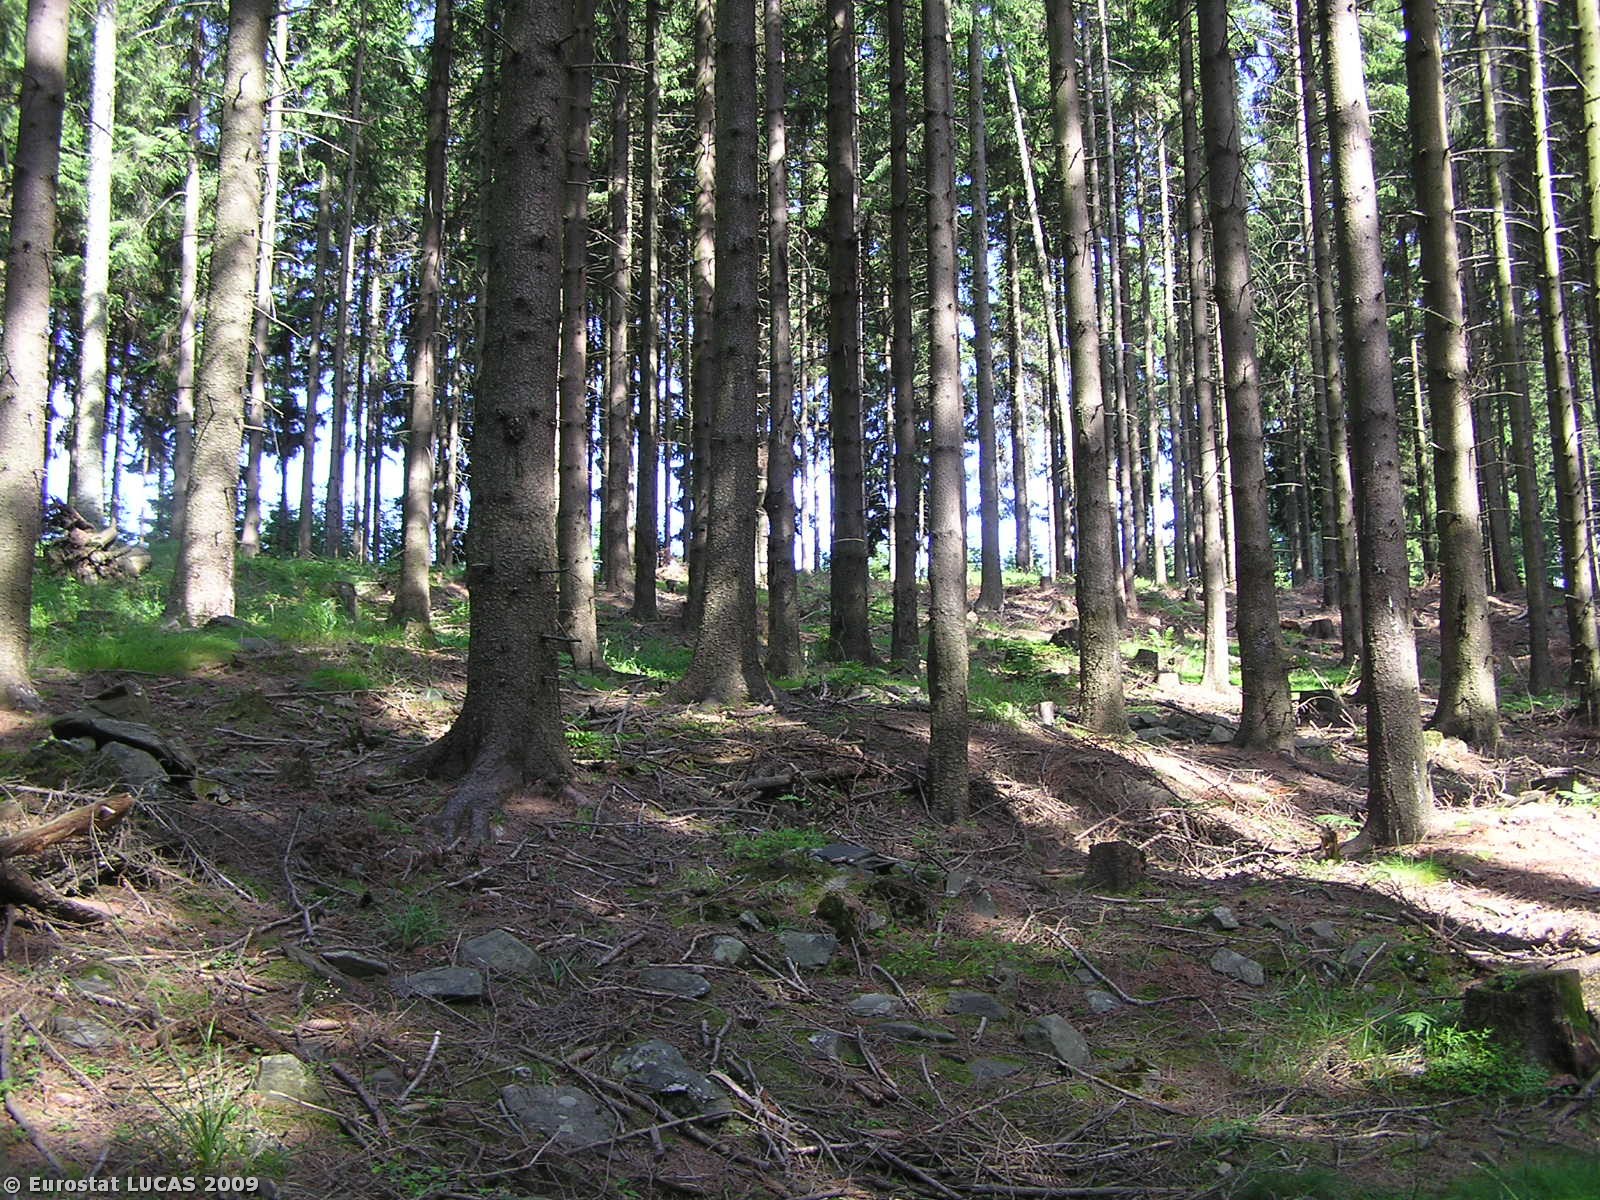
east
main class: Woodland
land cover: Coniferous woodland
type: hemiboreal forest and nemoral coniferous forest and mixed broadleaved-coniferous forest
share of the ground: > 75 %
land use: Forestry
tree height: > 5 m
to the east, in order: Coniferous woodland; Tracks; Coniferous woodland
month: July
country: CZ
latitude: 50.1611
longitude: 17.3889
